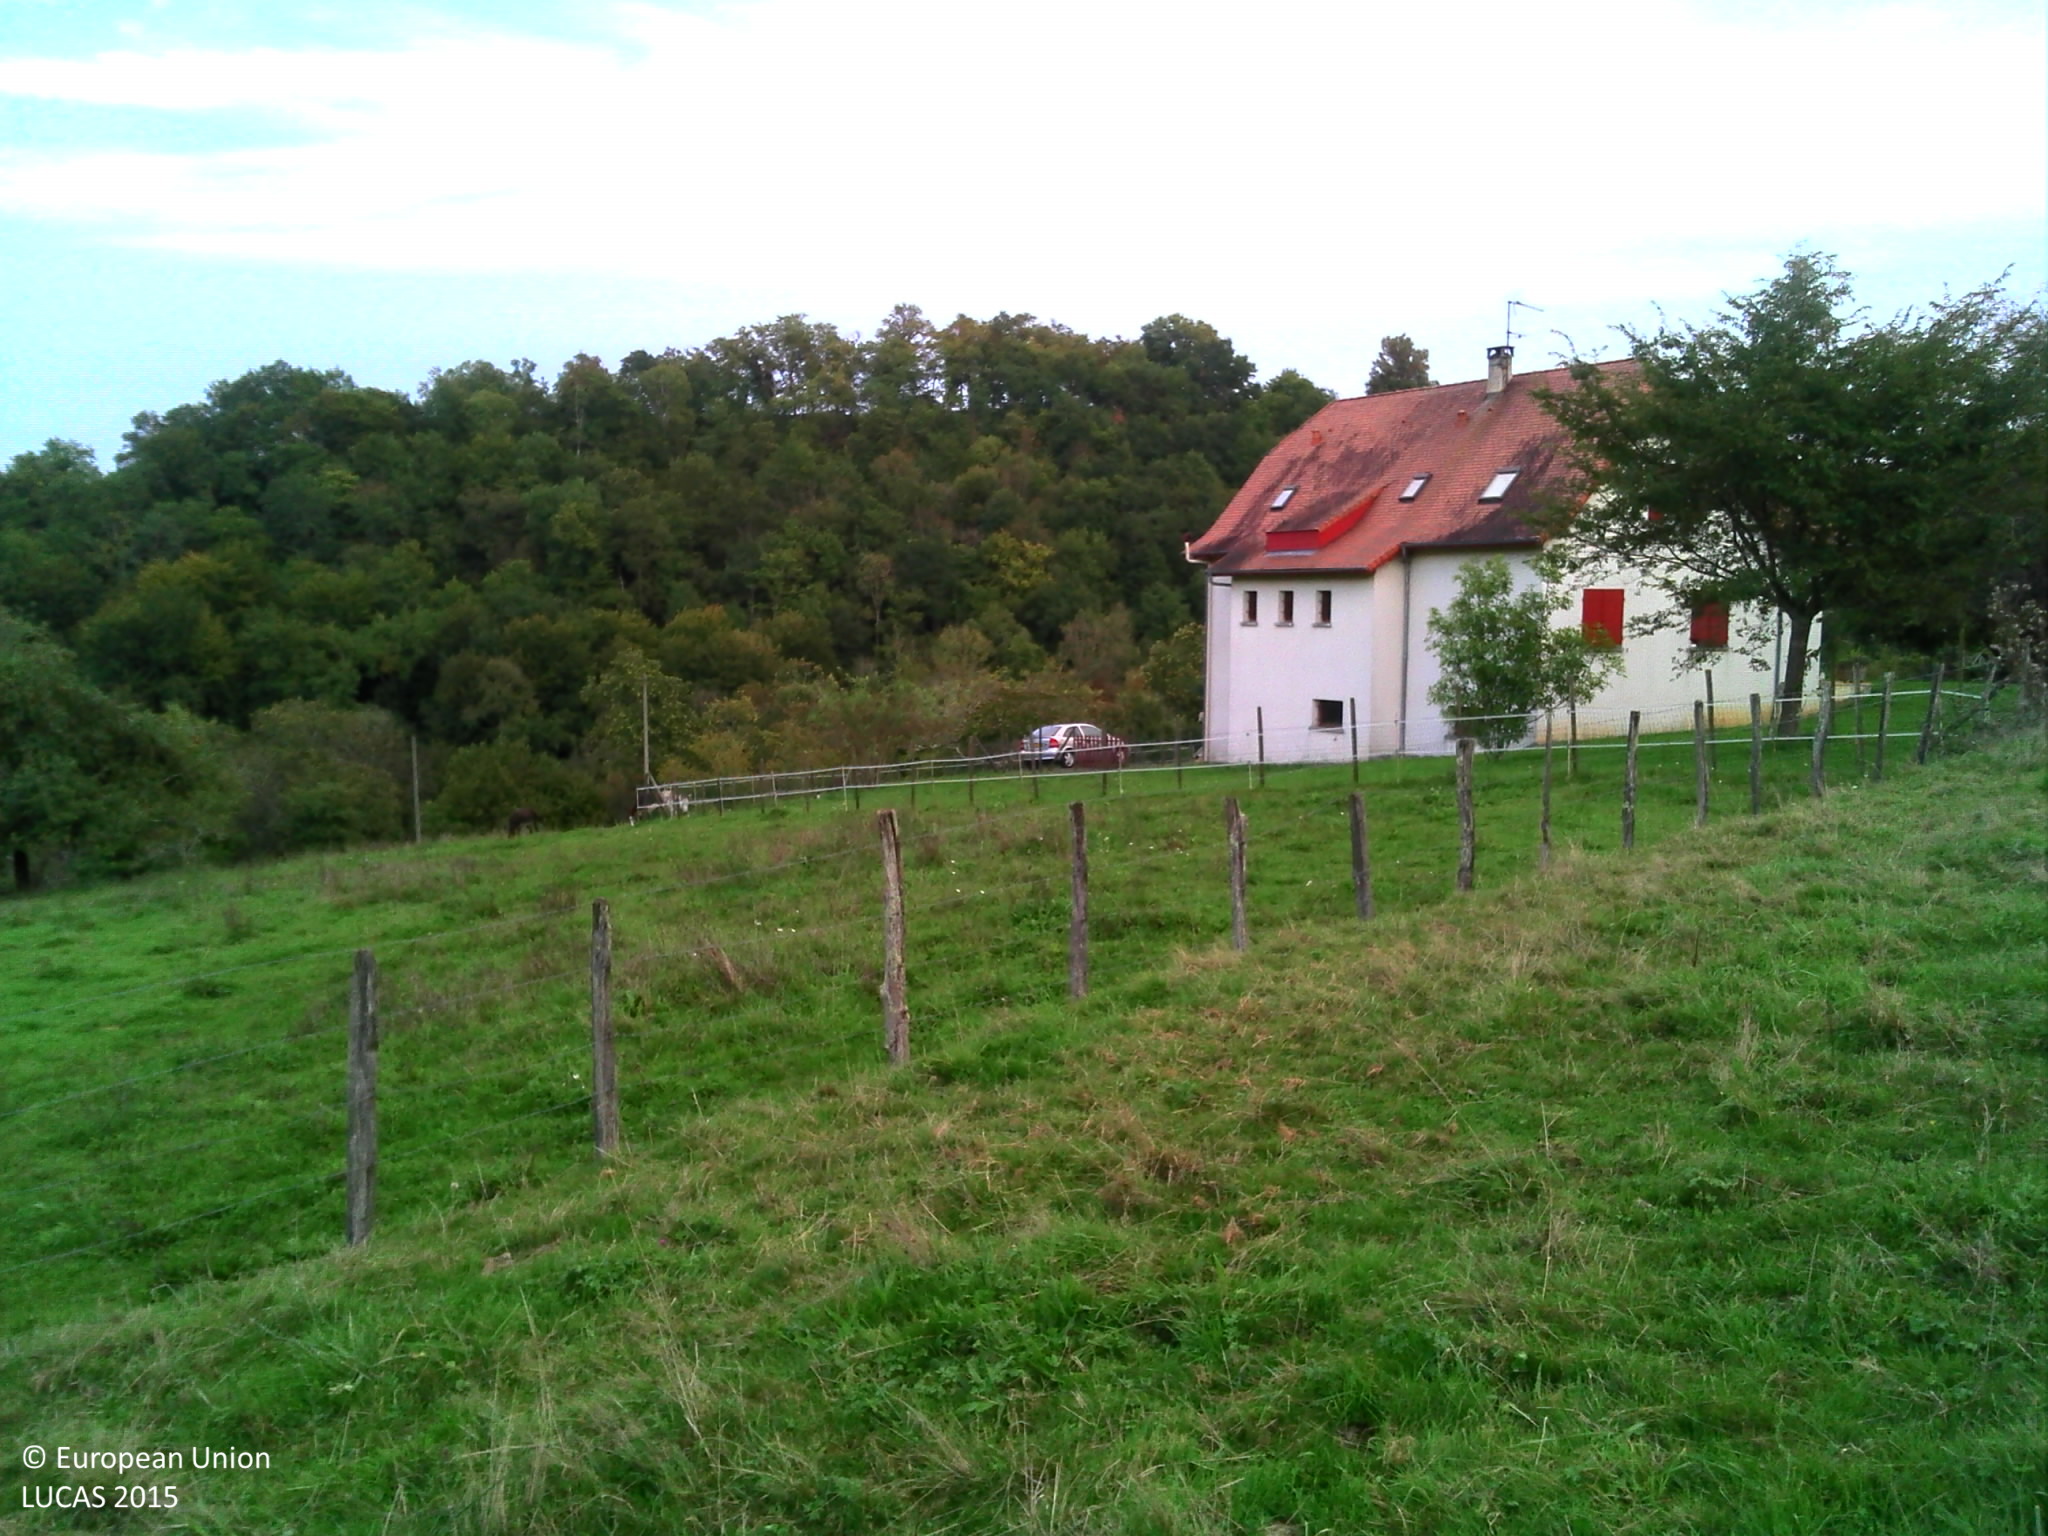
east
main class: Grassland
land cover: Grassland without tree/shrub cover
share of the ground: > 75 %
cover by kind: herbaceous plants 100 %
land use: Agriculture (excluding fallow land and kitchen gardens)
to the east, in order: Grassland without tree/shrub cover; Fences; Grassland without tree/shrub cover; Fences; Artificial constructions in urban areas; Grassland with sparse tree/shrub cover; Fences; Grassland without tree/shrub cover; Electric lines; Grassland without tree/shrub cover; Grassland with sparse tree/shrub cover; Fences; Broadleaved woodland; Tracks; Grass margins; Fences; Electric lines; Broadleaved woodland; Fences; Broadleaved woodland; Grassland without tree/shrub cover; Fences; Grassland without tree/shrub cover; Broadleaved woodland
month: September
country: FR
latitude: 43.2614
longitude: -0.4165
